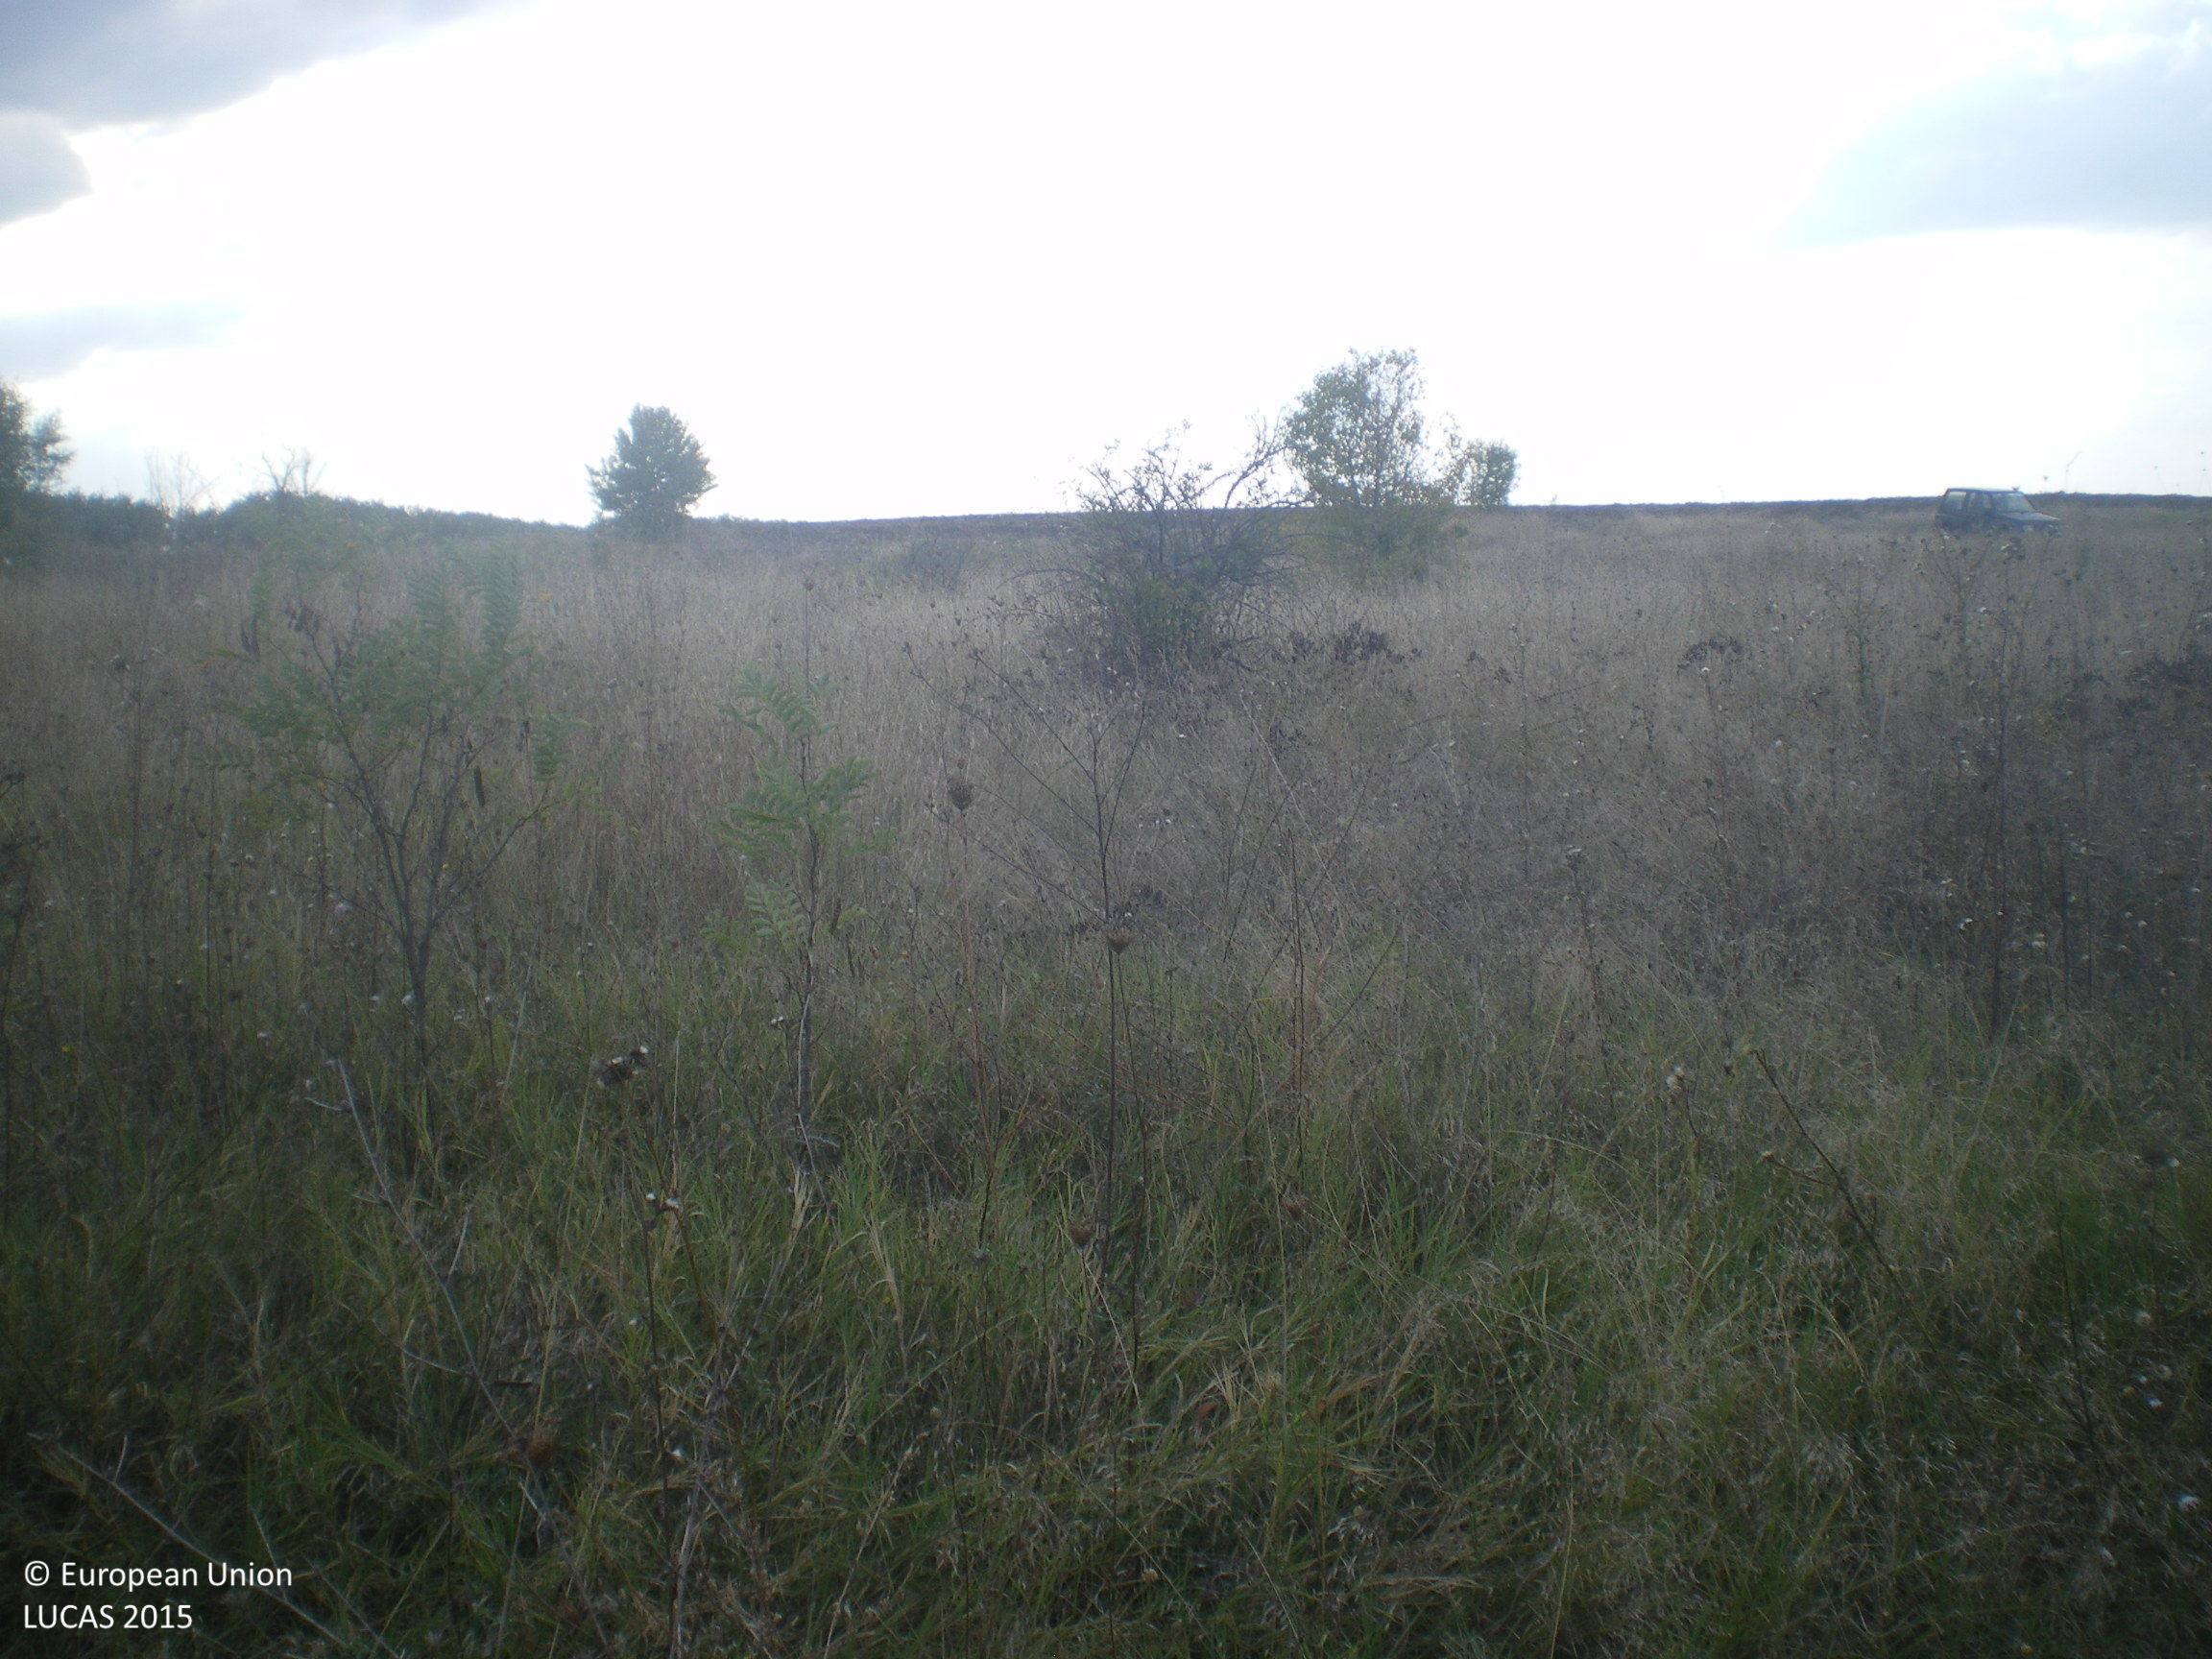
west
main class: Grassland
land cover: Grassland with sparse tree/shrub cover
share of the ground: > 75 %
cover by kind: herbaceous plants 85 %, shrubs 10 %, broadleaved forest trees 5 %
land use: Agriculture (excluding fallow land and kitchen gardens)
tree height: < 5 m
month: September
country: BG
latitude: 42.0956
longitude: 26.0736
